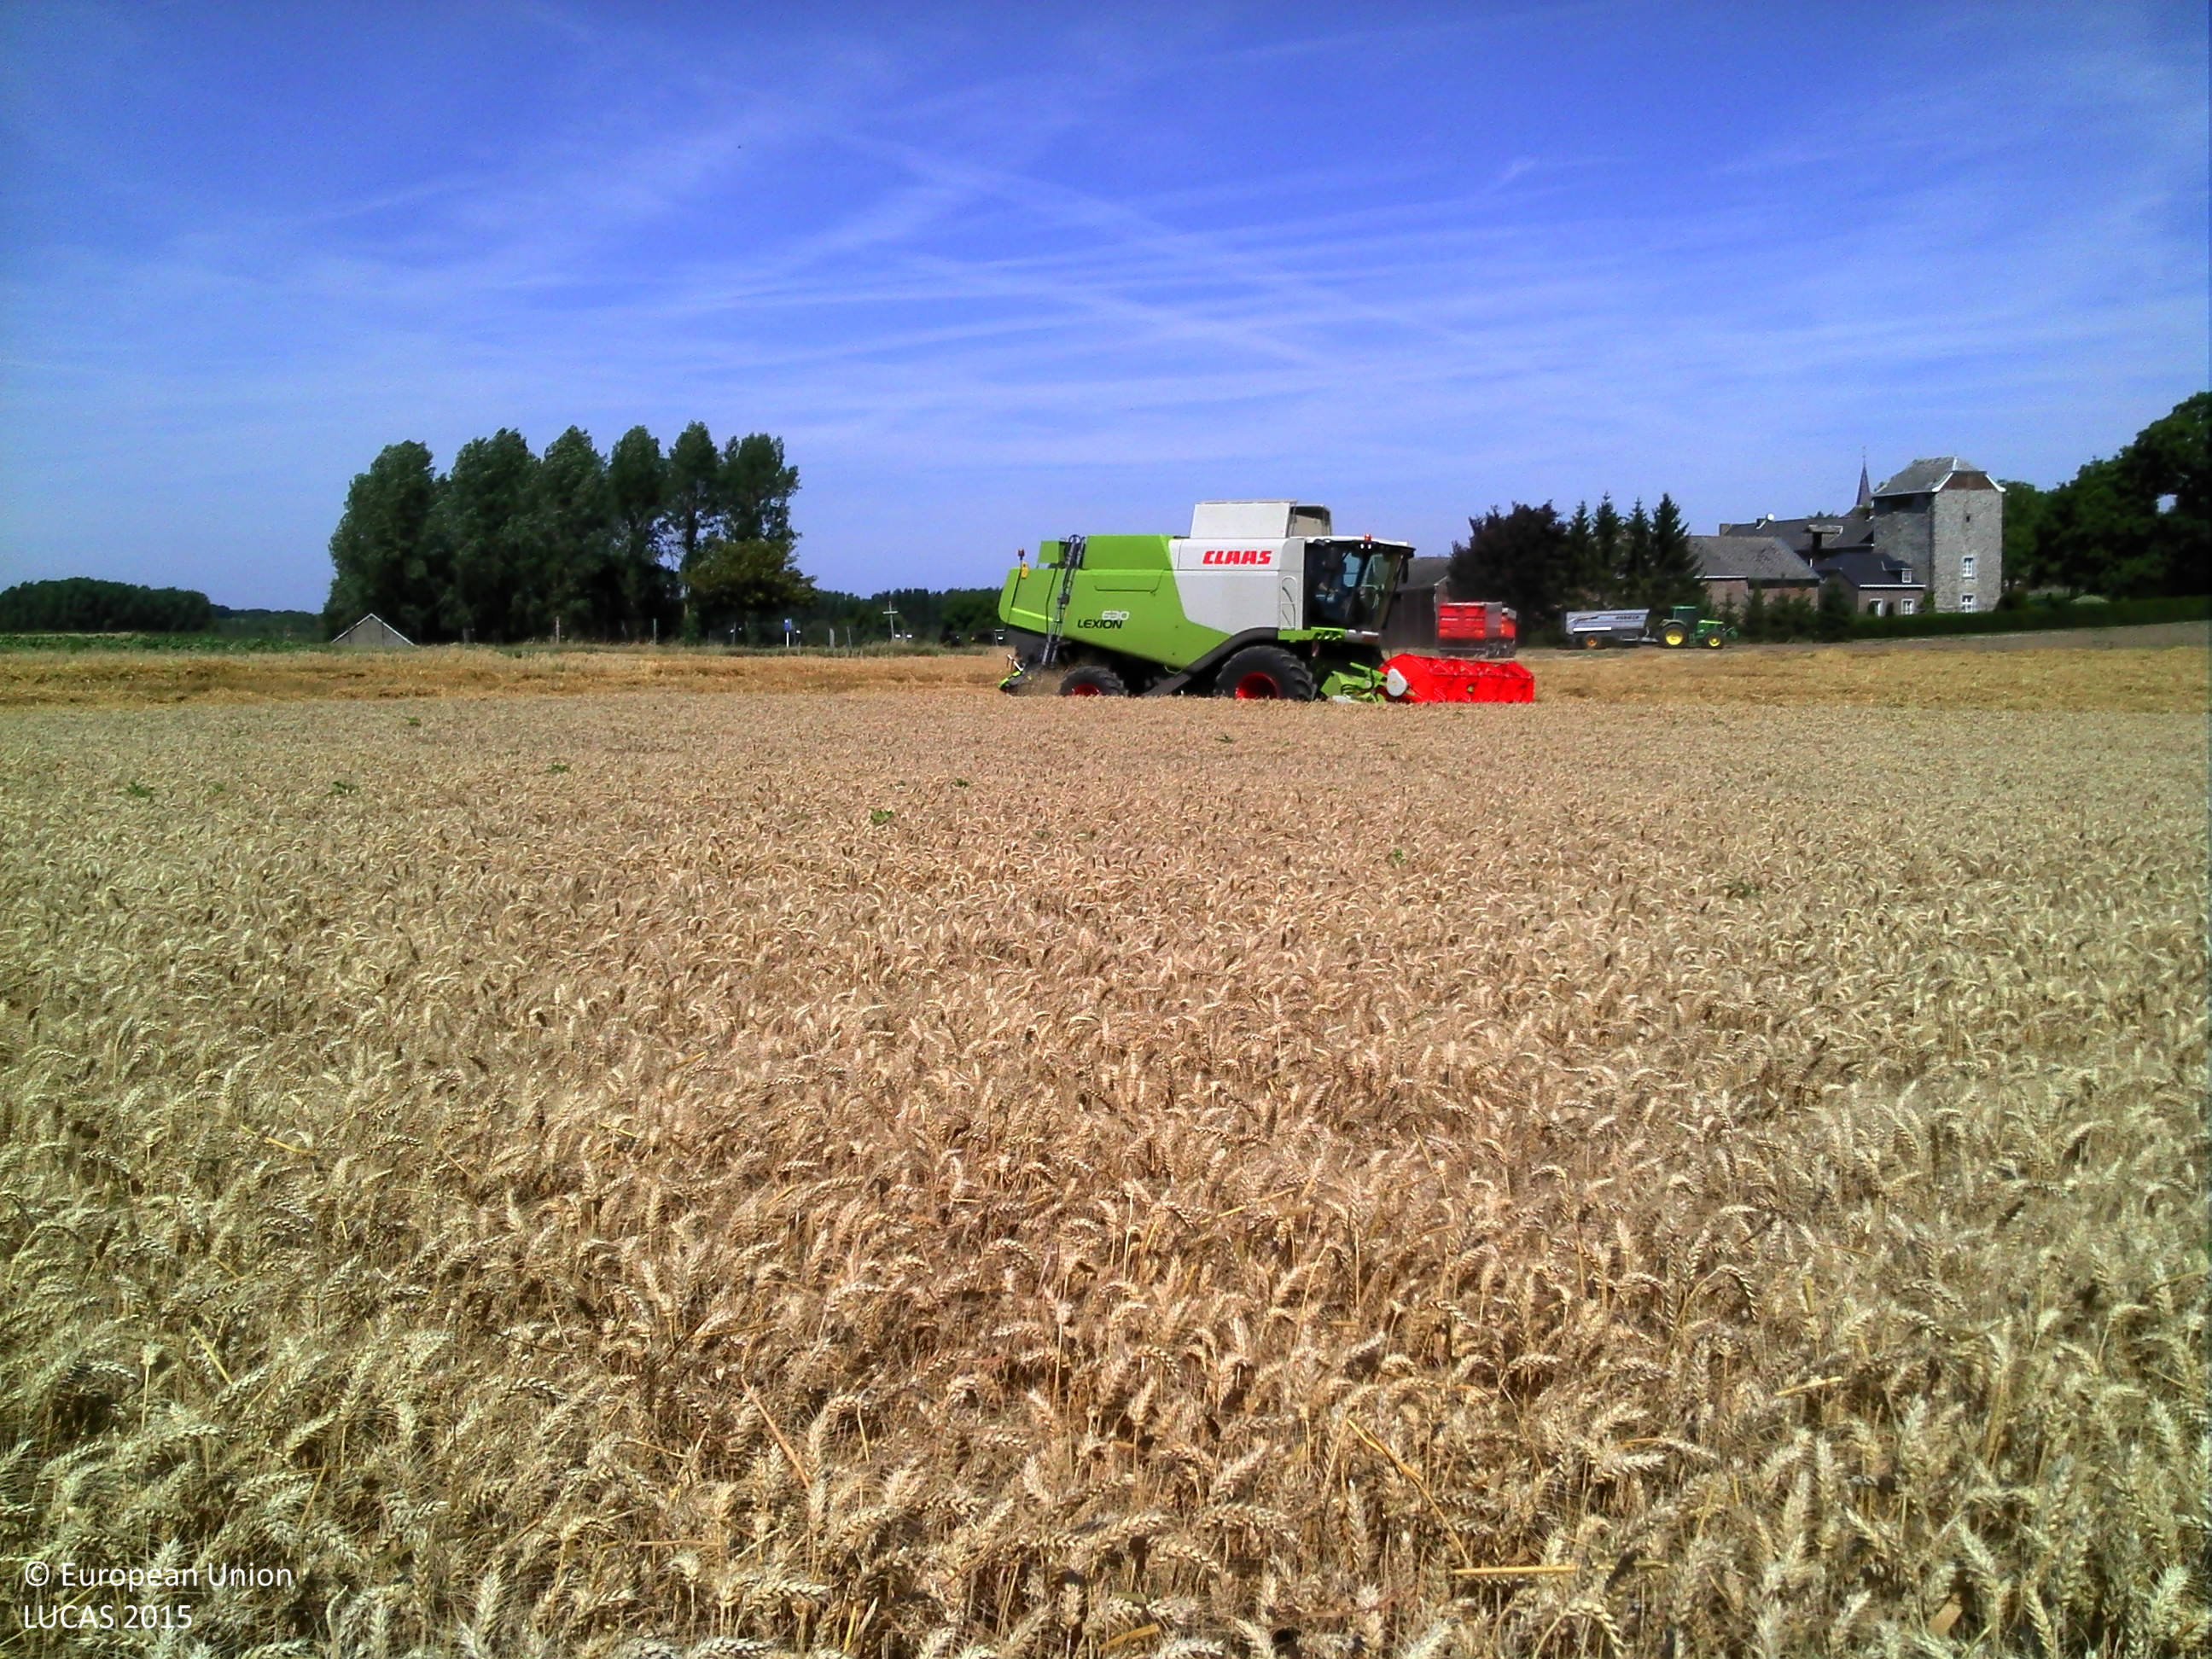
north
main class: Cropland
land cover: Common wheat
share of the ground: > 75 %
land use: Agriculture (excluding fallow land and kitchen gardens)
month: August
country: BE
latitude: 50.7350
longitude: 5.2795
